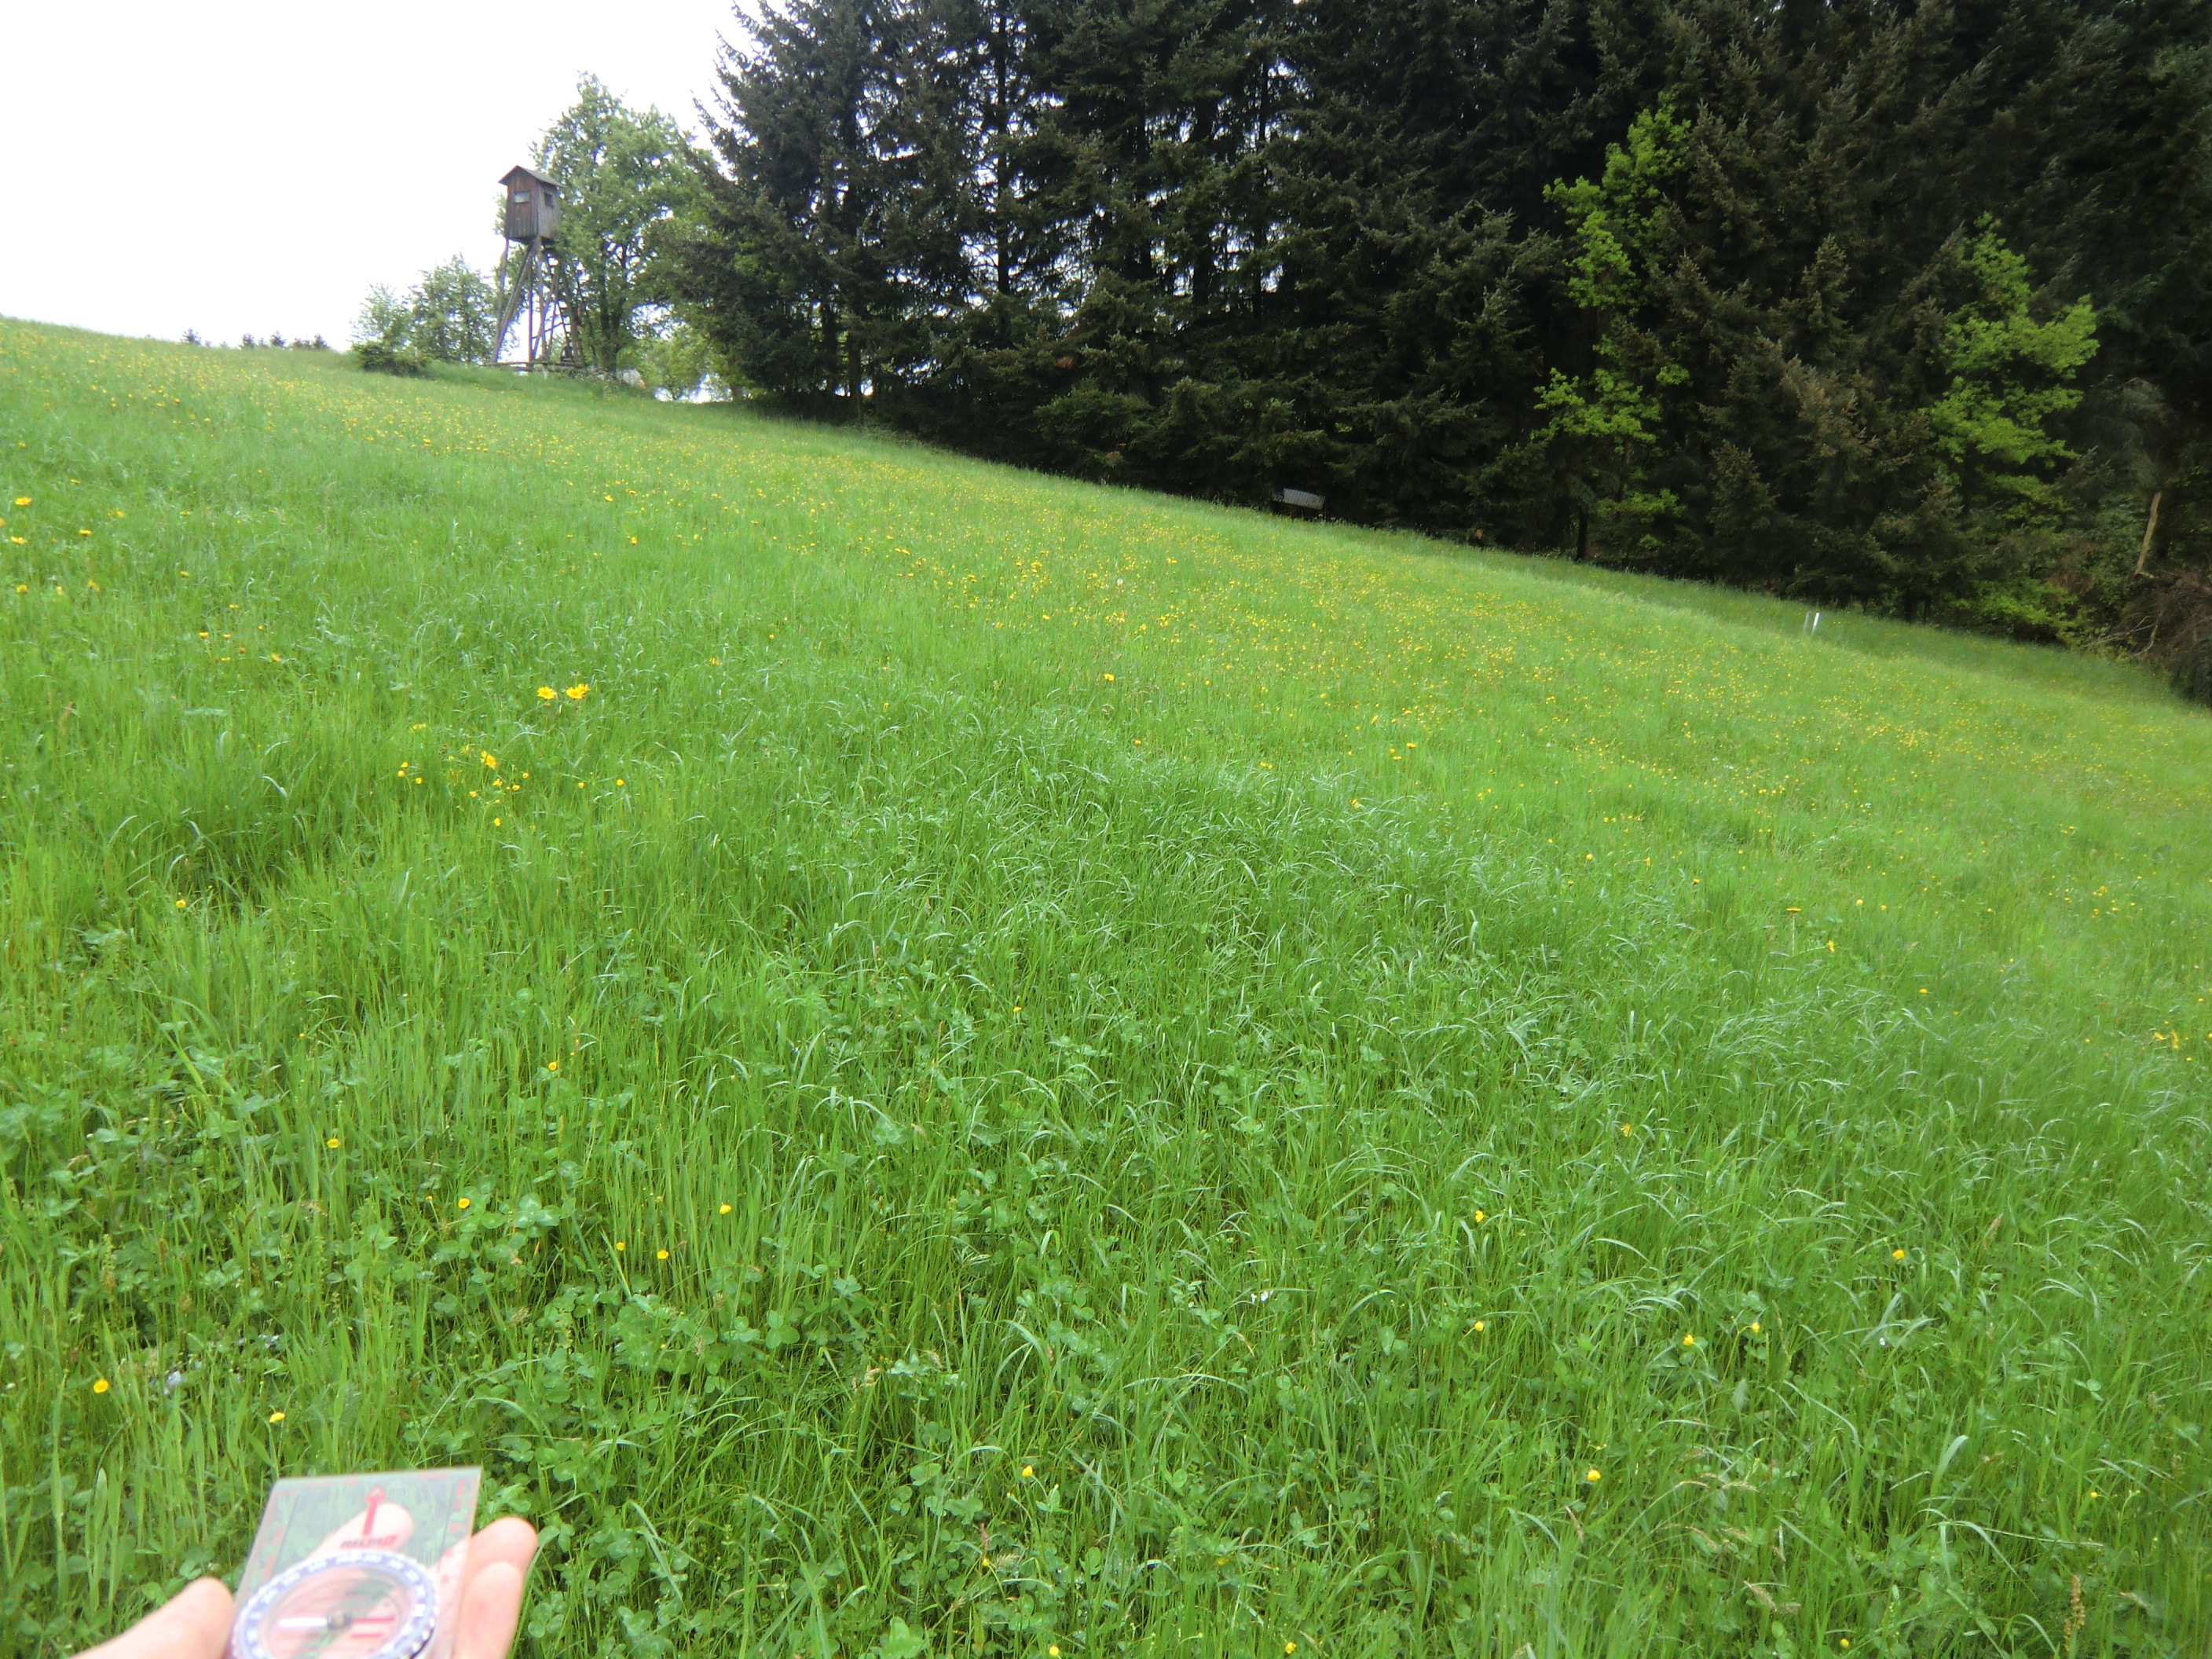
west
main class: Grassland
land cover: Grassland without tree/shrub cover
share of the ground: > 75 %
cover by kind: herbaceous plants 100 %
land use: Agriculture (excluding fallow land and kitchen gardens)
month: May
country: AT
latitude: 48.2854
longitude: 14.7042
